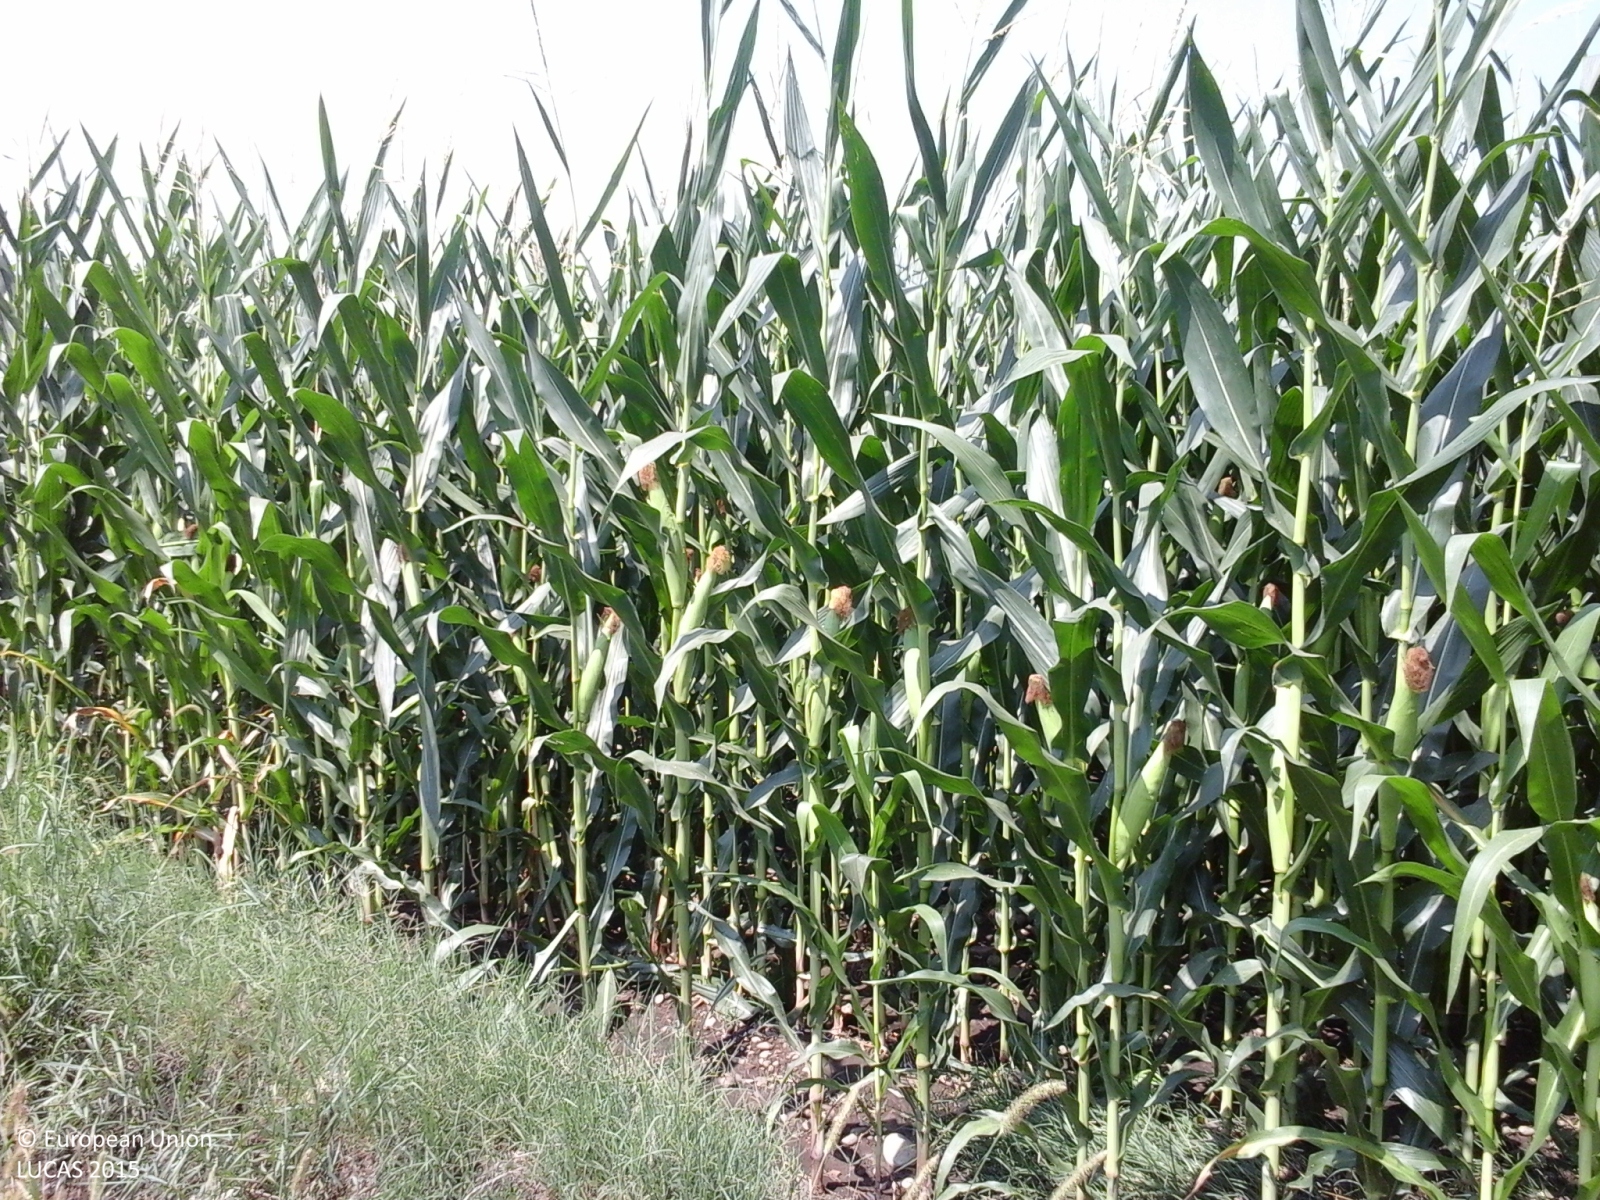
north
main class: Cropland
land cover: Maize
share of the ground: > 75 %
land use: Agriculture (excluding fallow land and kitchen gardens)
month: July
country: IT
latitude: 44.3963
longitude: 7.6572
